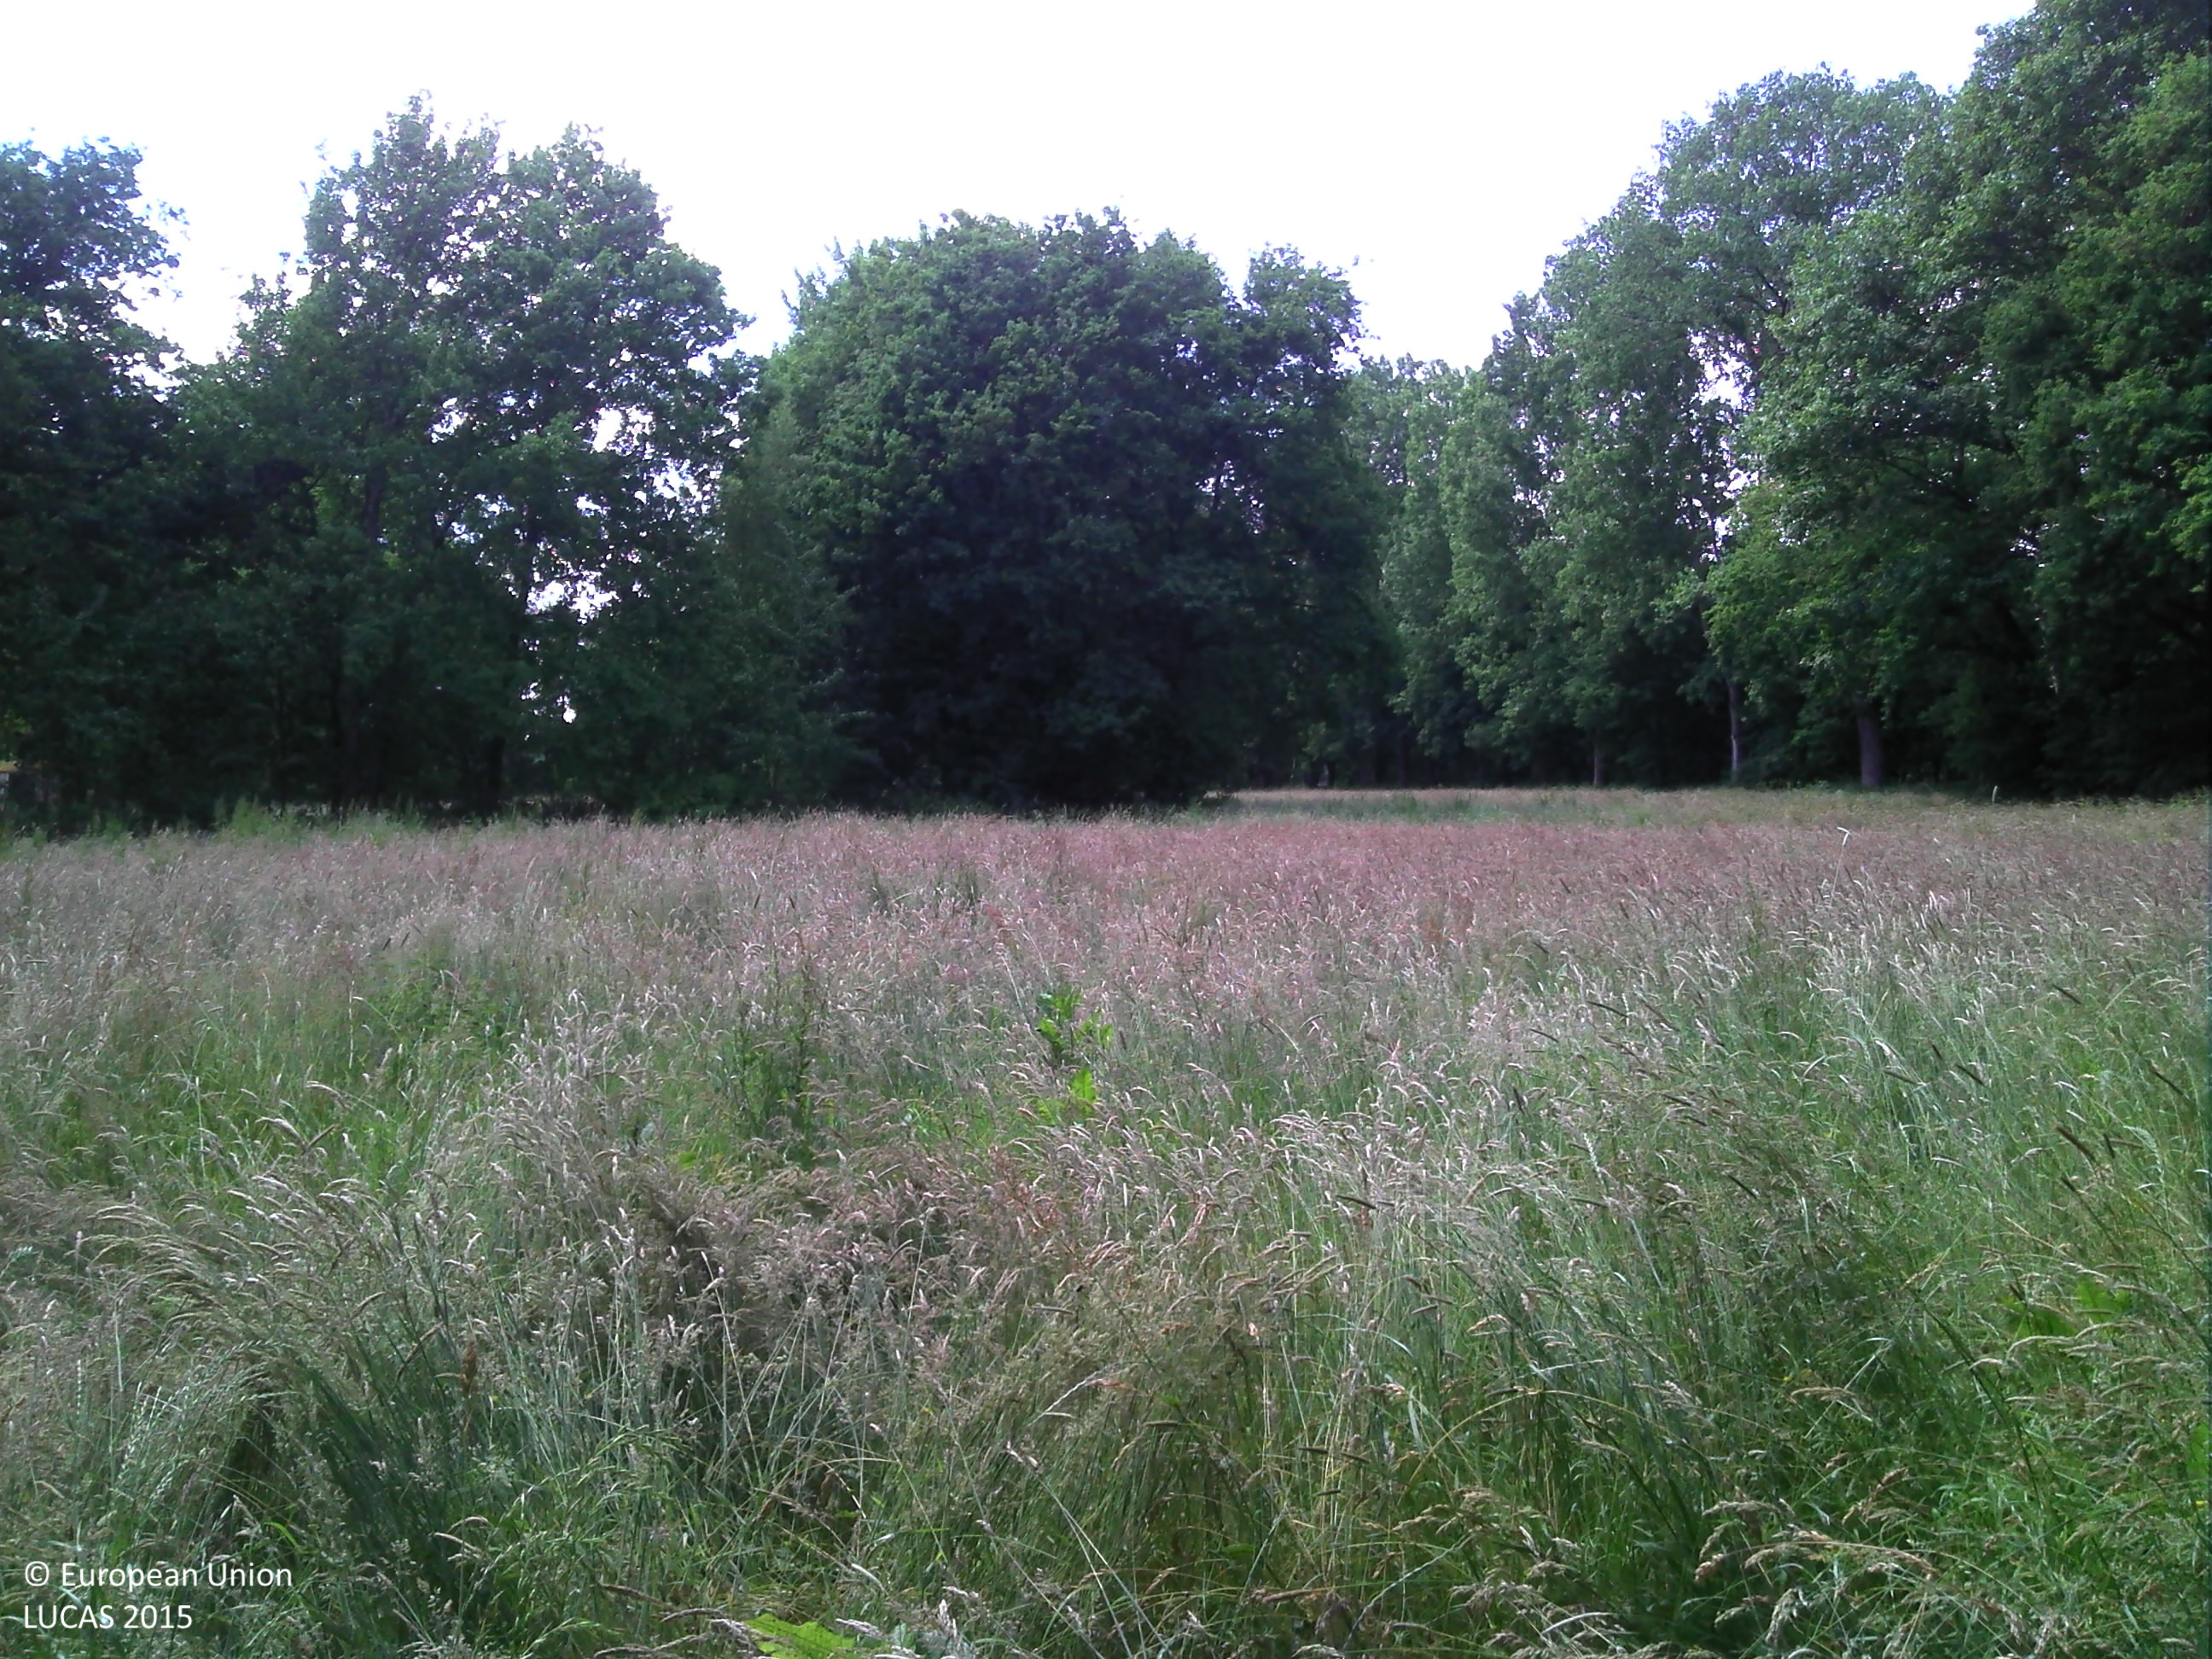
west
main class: Grassland
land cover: Grassland without tree/shrub cover
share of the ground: > 75 %
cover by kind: herbaceous plants 100 %
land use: Agriculture (excluding fallow land and kitchen gardens)
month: June
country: BE
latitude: 51.0946
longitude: 5.7292
